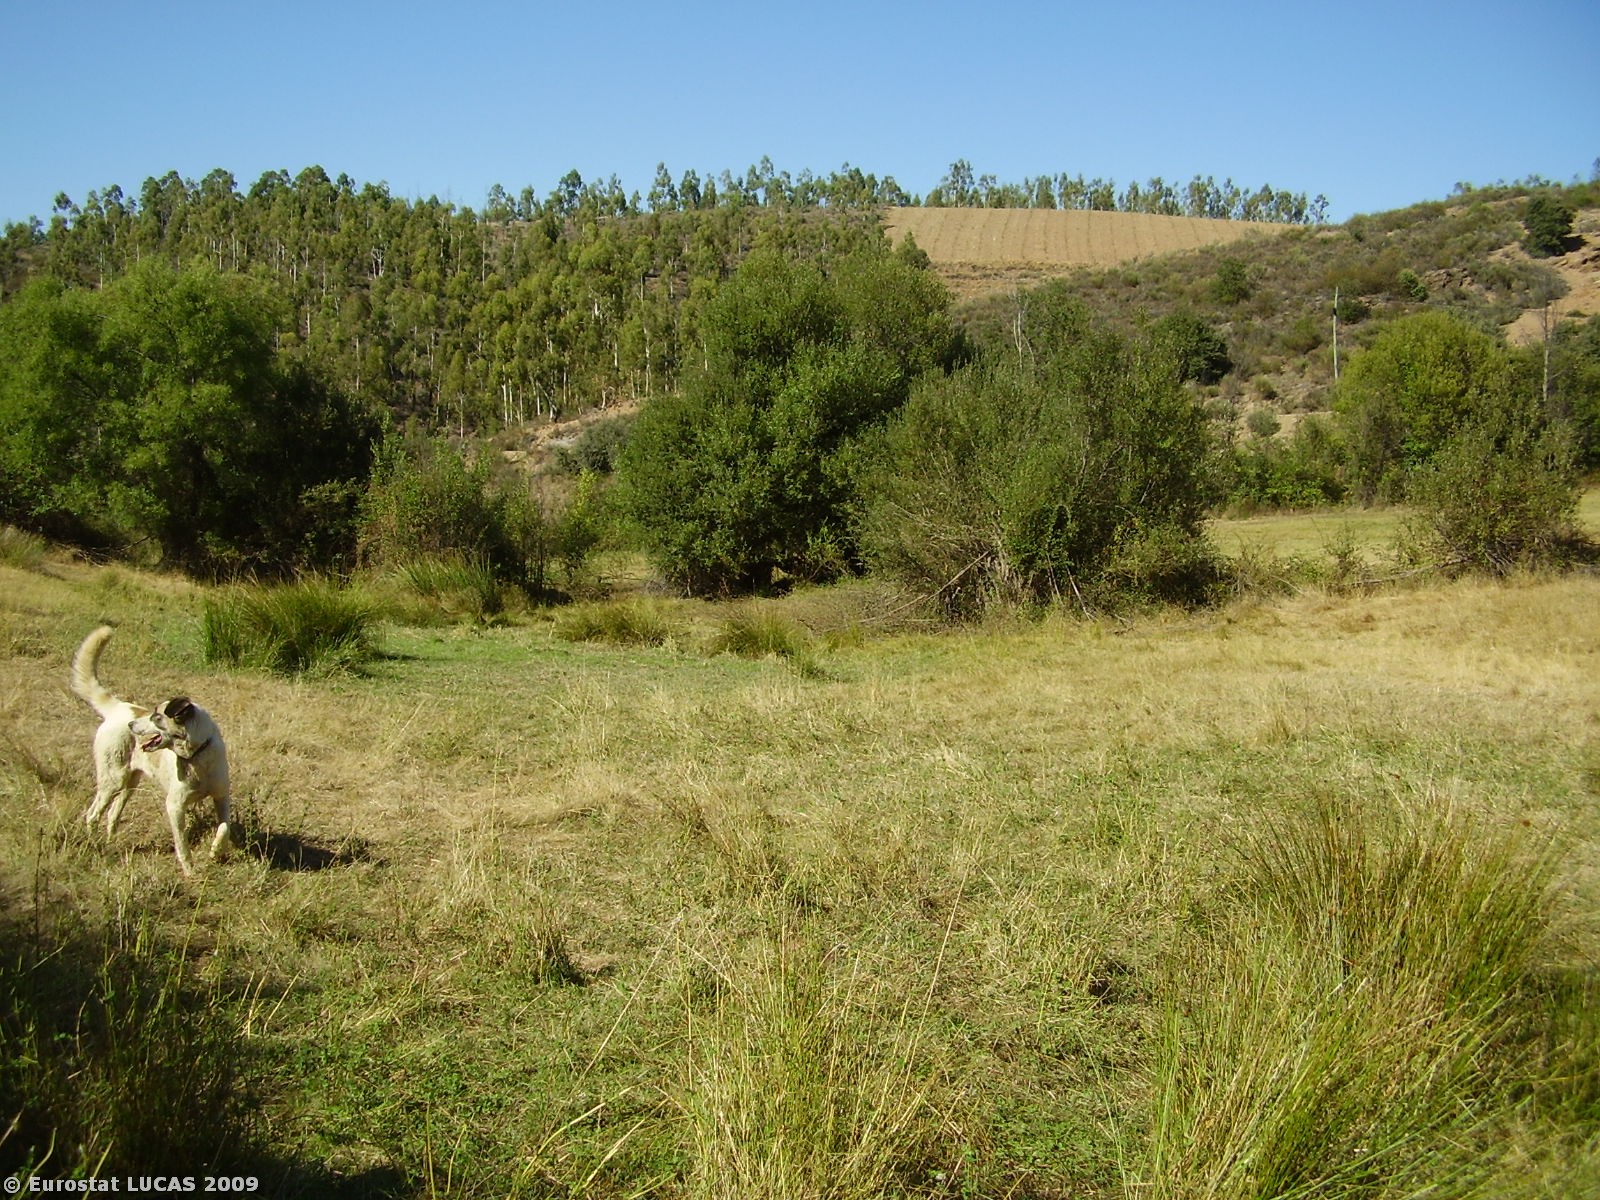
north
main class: Grassland
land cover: Spontaneously vegetated surfaces
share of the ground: > 75 %
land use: Fallow land
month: August
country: PT
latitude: 41.2784
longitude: -6.7846
